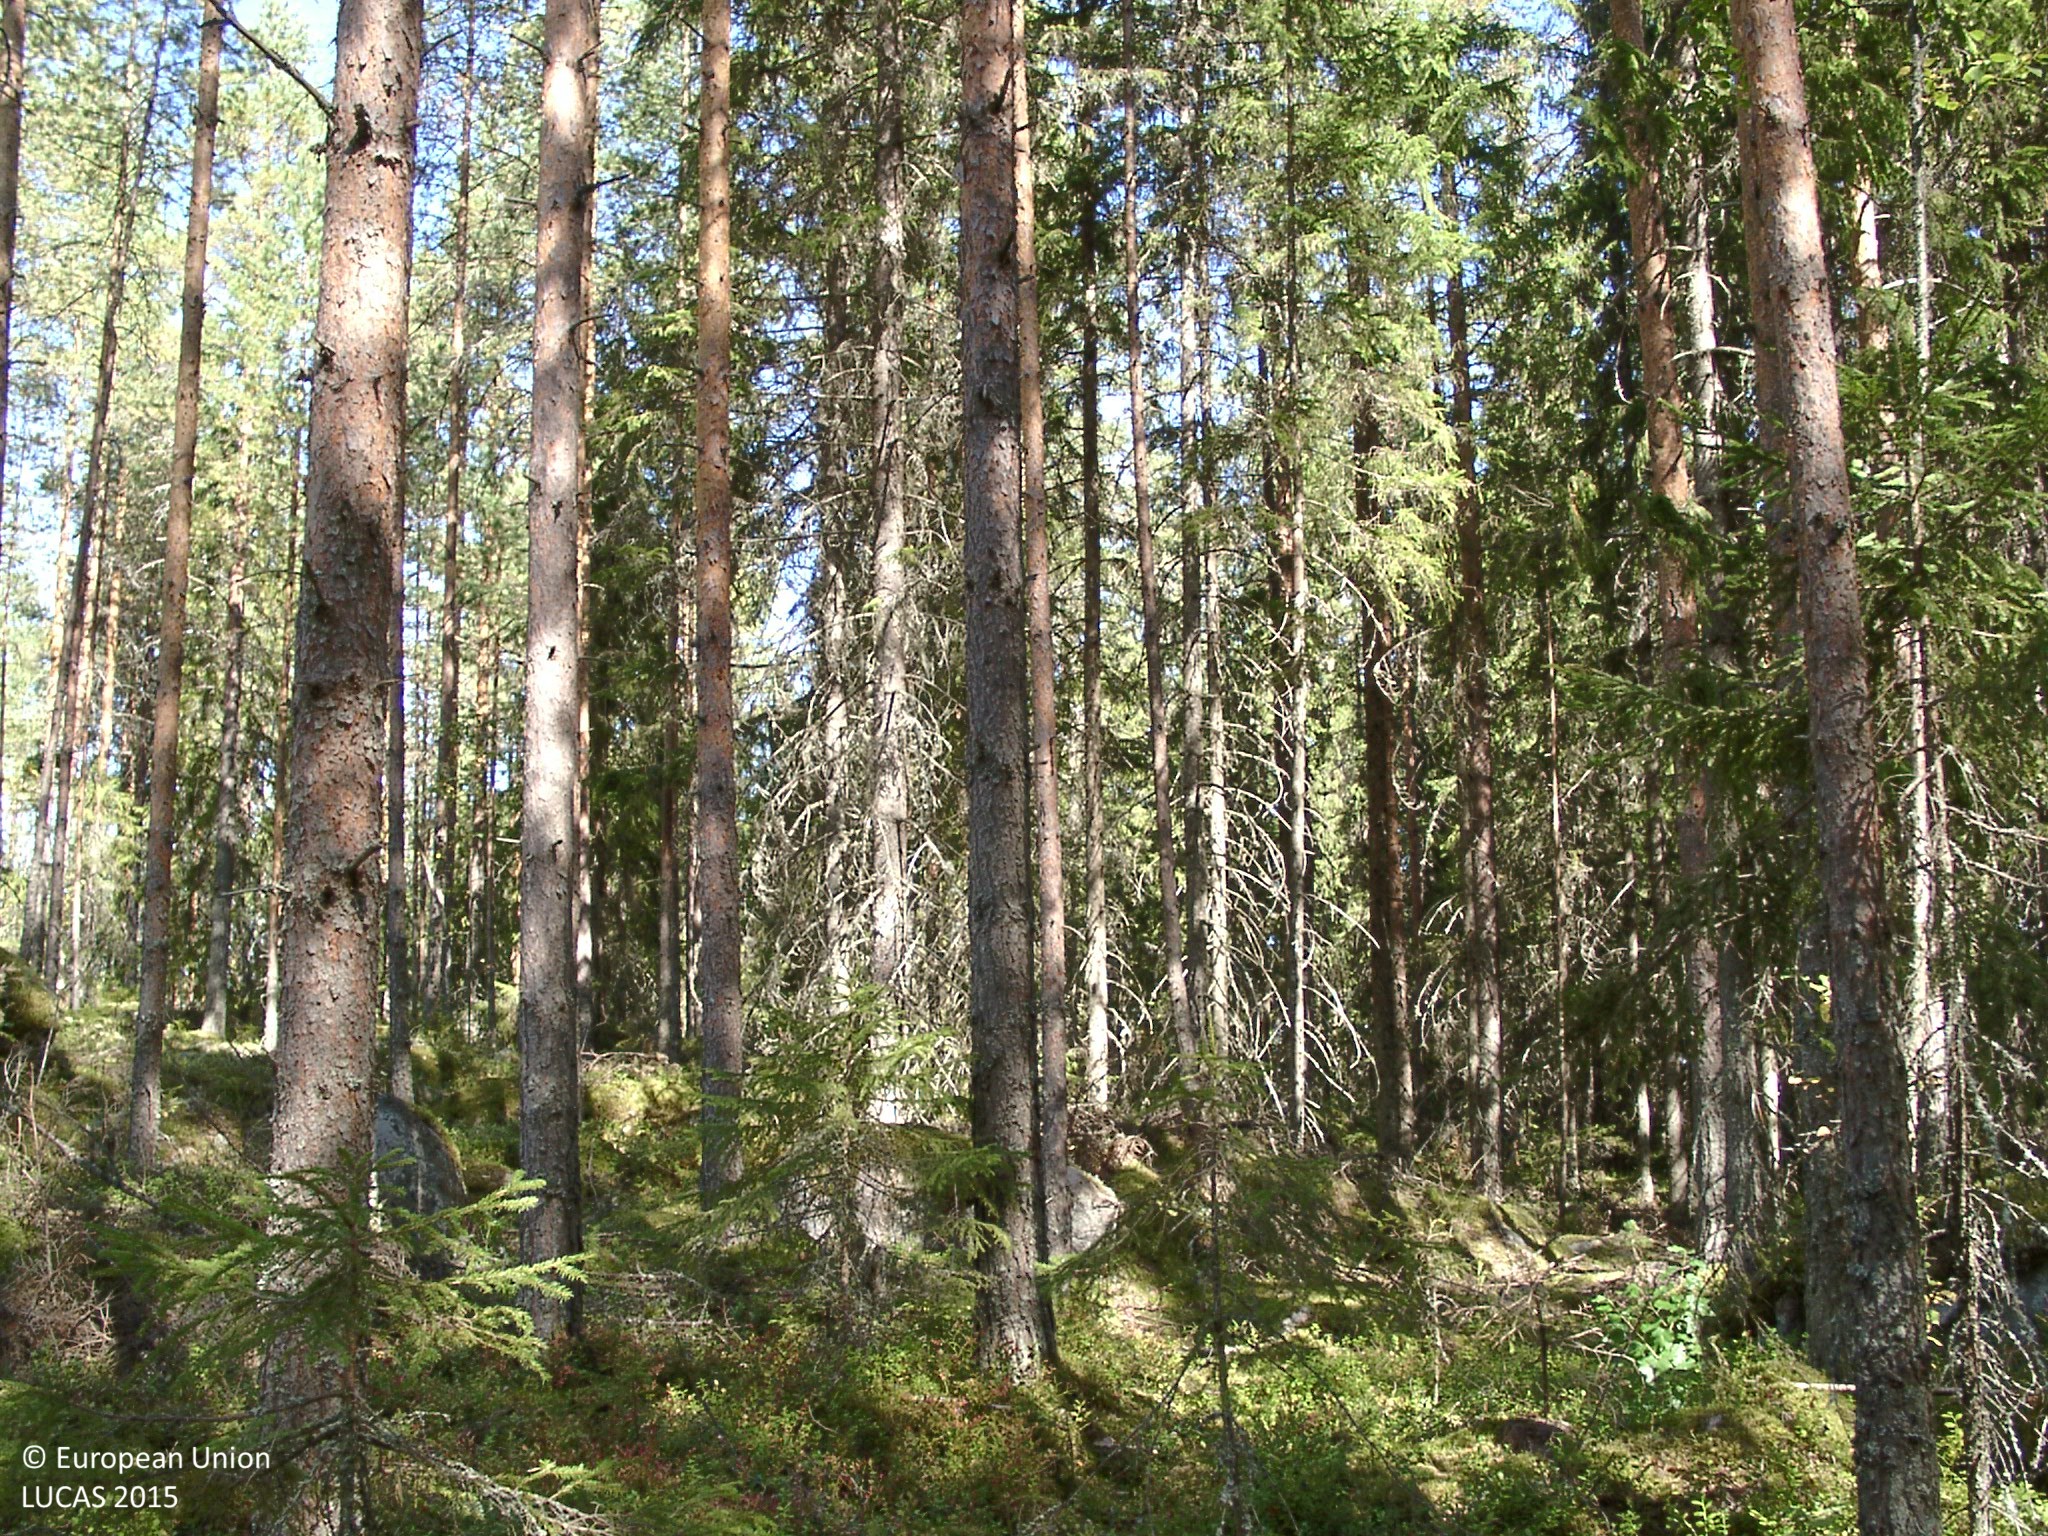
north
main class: Woodland
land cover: Other coniferous woodland
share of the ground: 50 - 75 %
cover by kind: coniferous forest trees 60 %, lichens and mosses 20 %, broadleaved forest trees 10 %, shrubs 10 %
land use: Forestry
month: August
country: FI
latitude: 61.7377
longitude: 25.2389
